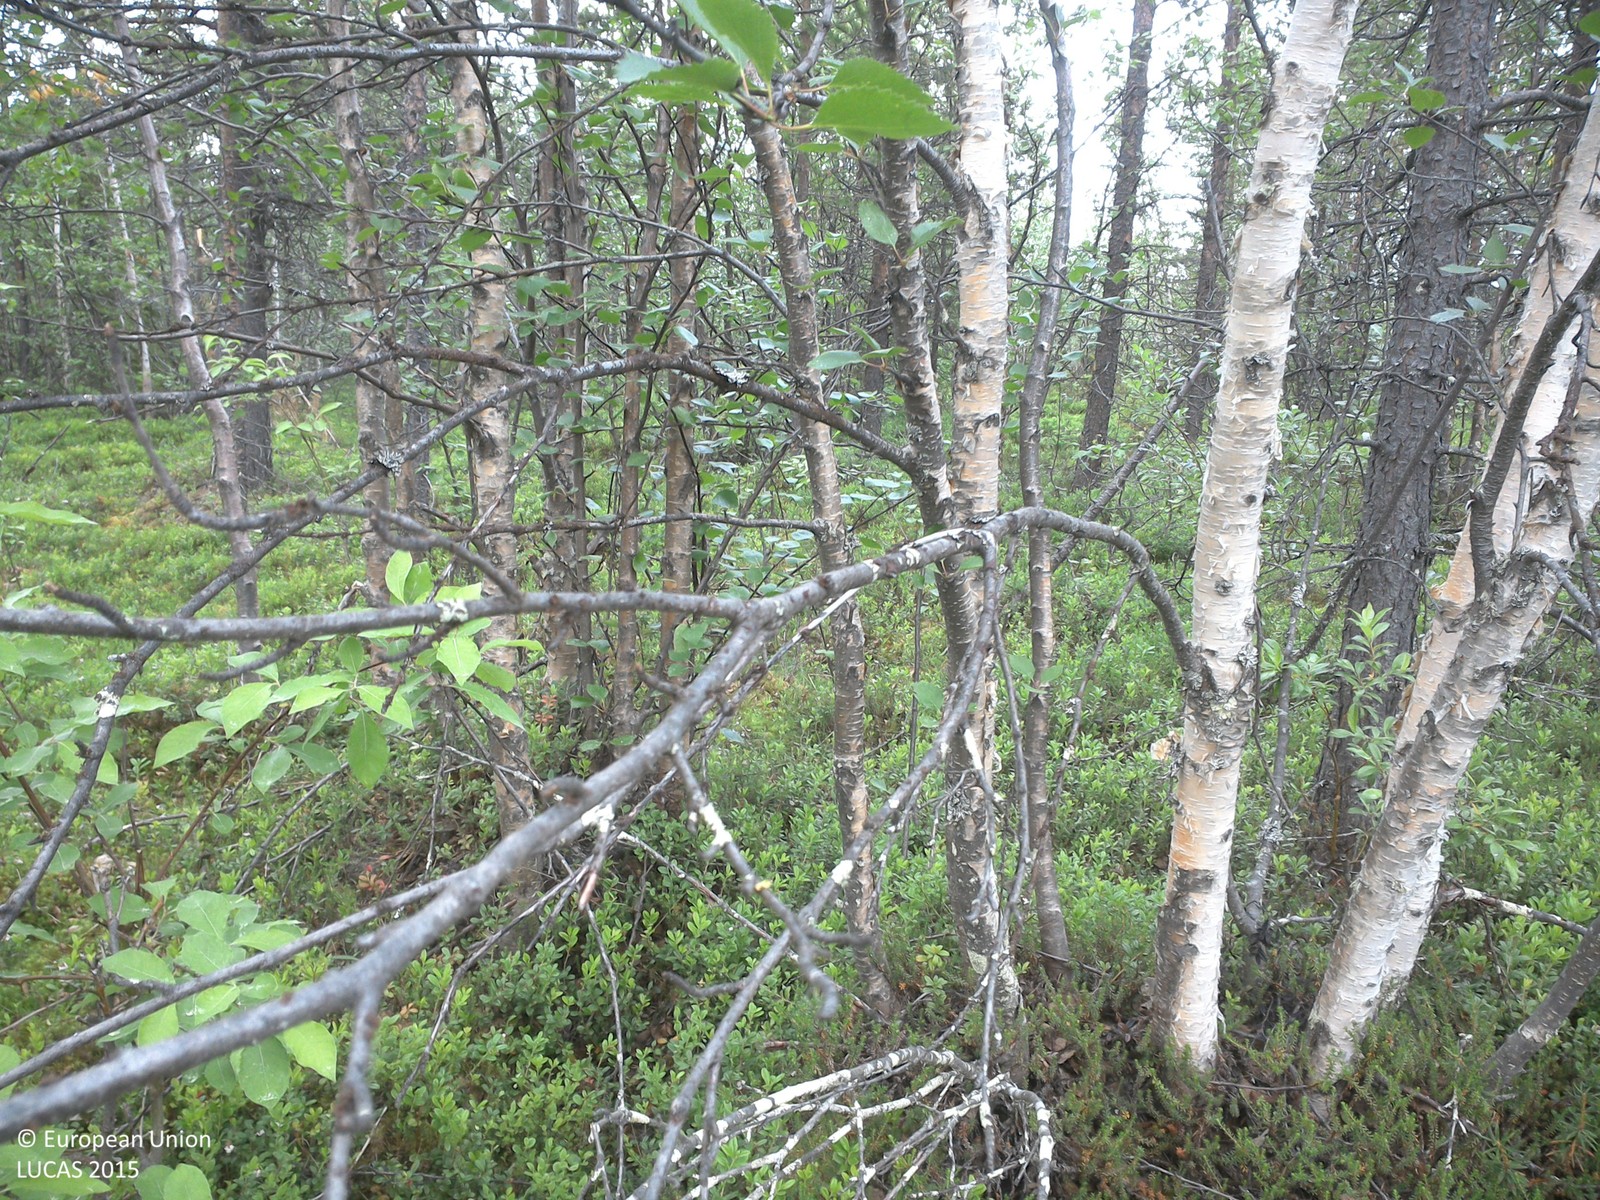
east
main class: Woodland
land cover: Pine dominated mixed woodland
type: boreal forest
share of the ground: 25 - 50 %
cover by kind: shrubs 60 %, coniferous forest trees 20 %, broadleaved forest trees 15 %, lichens and mosses 5 %
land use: Forestry
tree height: > 5 m
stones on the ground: < 10 %
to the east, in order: Pine dominated mixed woodland
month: July
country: SE
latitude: 67.8061
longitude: 22.3589
